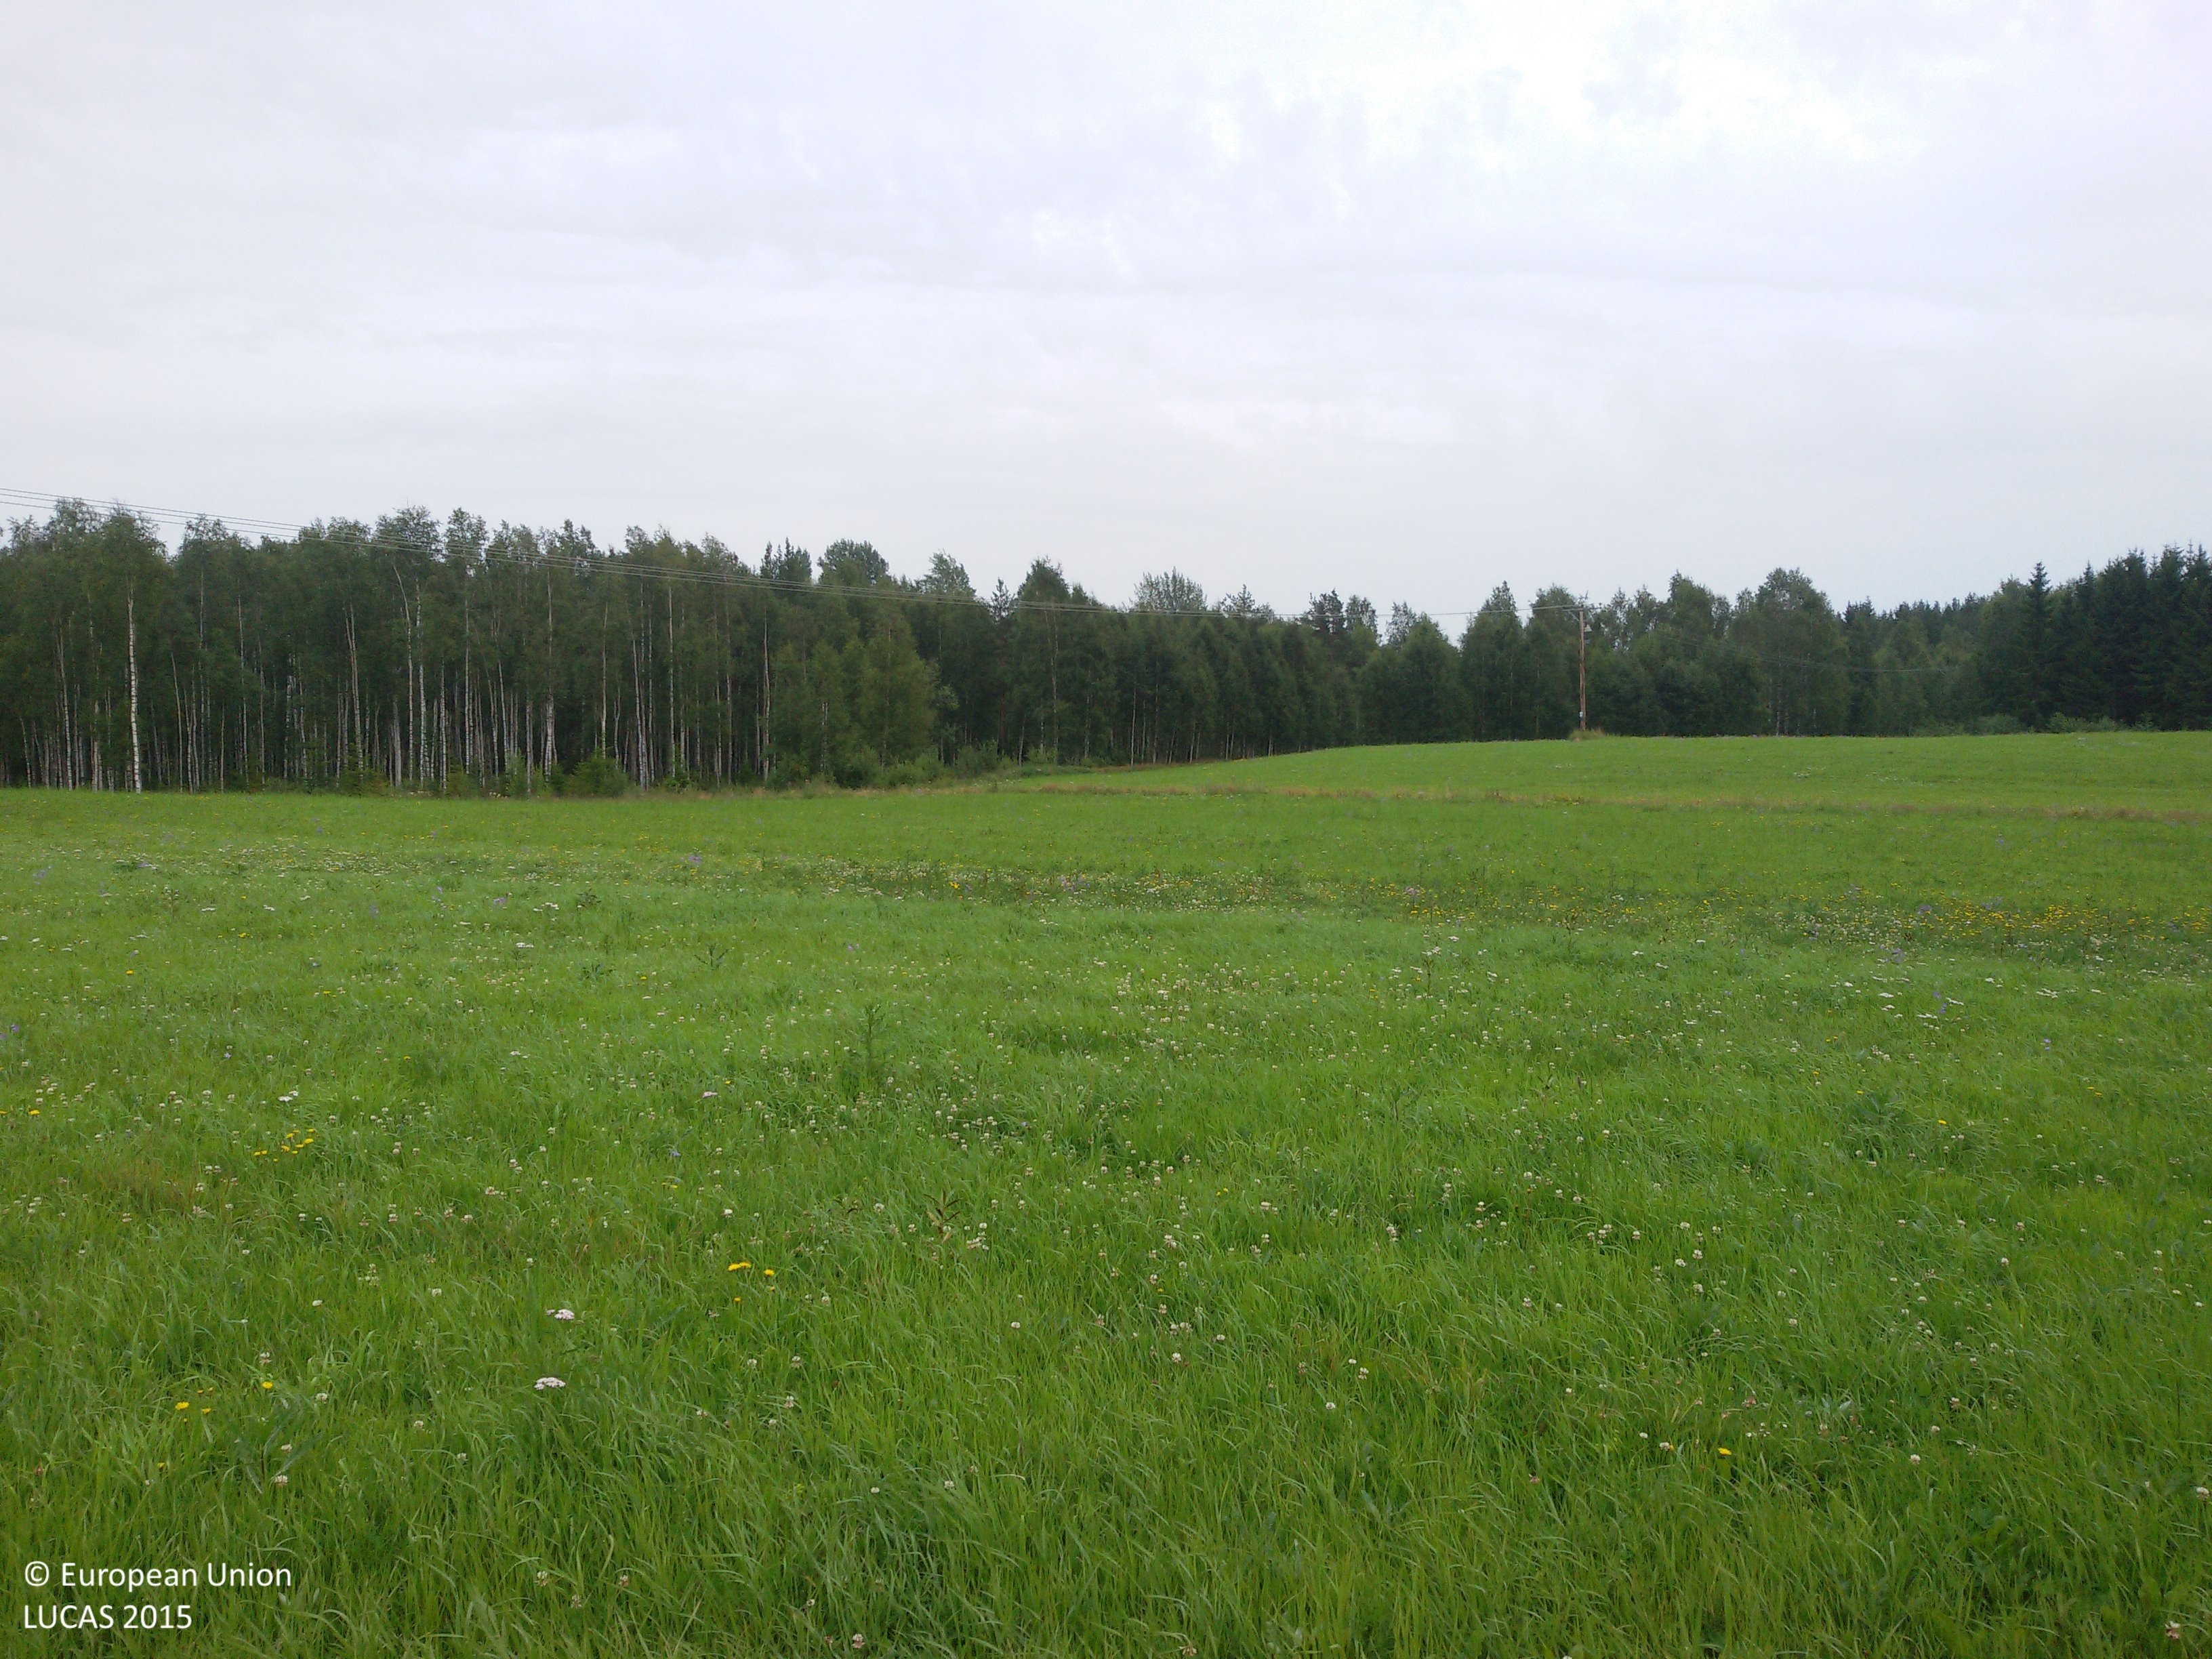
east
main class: Artificial land
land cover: Other artificial areas
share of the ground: > 75 %
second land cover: Grassland without tree/shrub cover
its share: > 75 %
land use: Electricity, gas and thermal power distribution
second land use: Agriculture (excluding fallow land and kitchen gardens)
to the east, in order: Electric lines; Grassland without tree/shrub cover; Electric lines; Grassland without tree/shrub cover; Ditches and canals; Grassland without tree/shrub cover; Broadleaved woodland; Spruce dominated mixed woodland; Rivers and streams; Spruce dominated mixed woodland
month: August
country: SE
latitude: 60.7325
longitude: 16.5706
